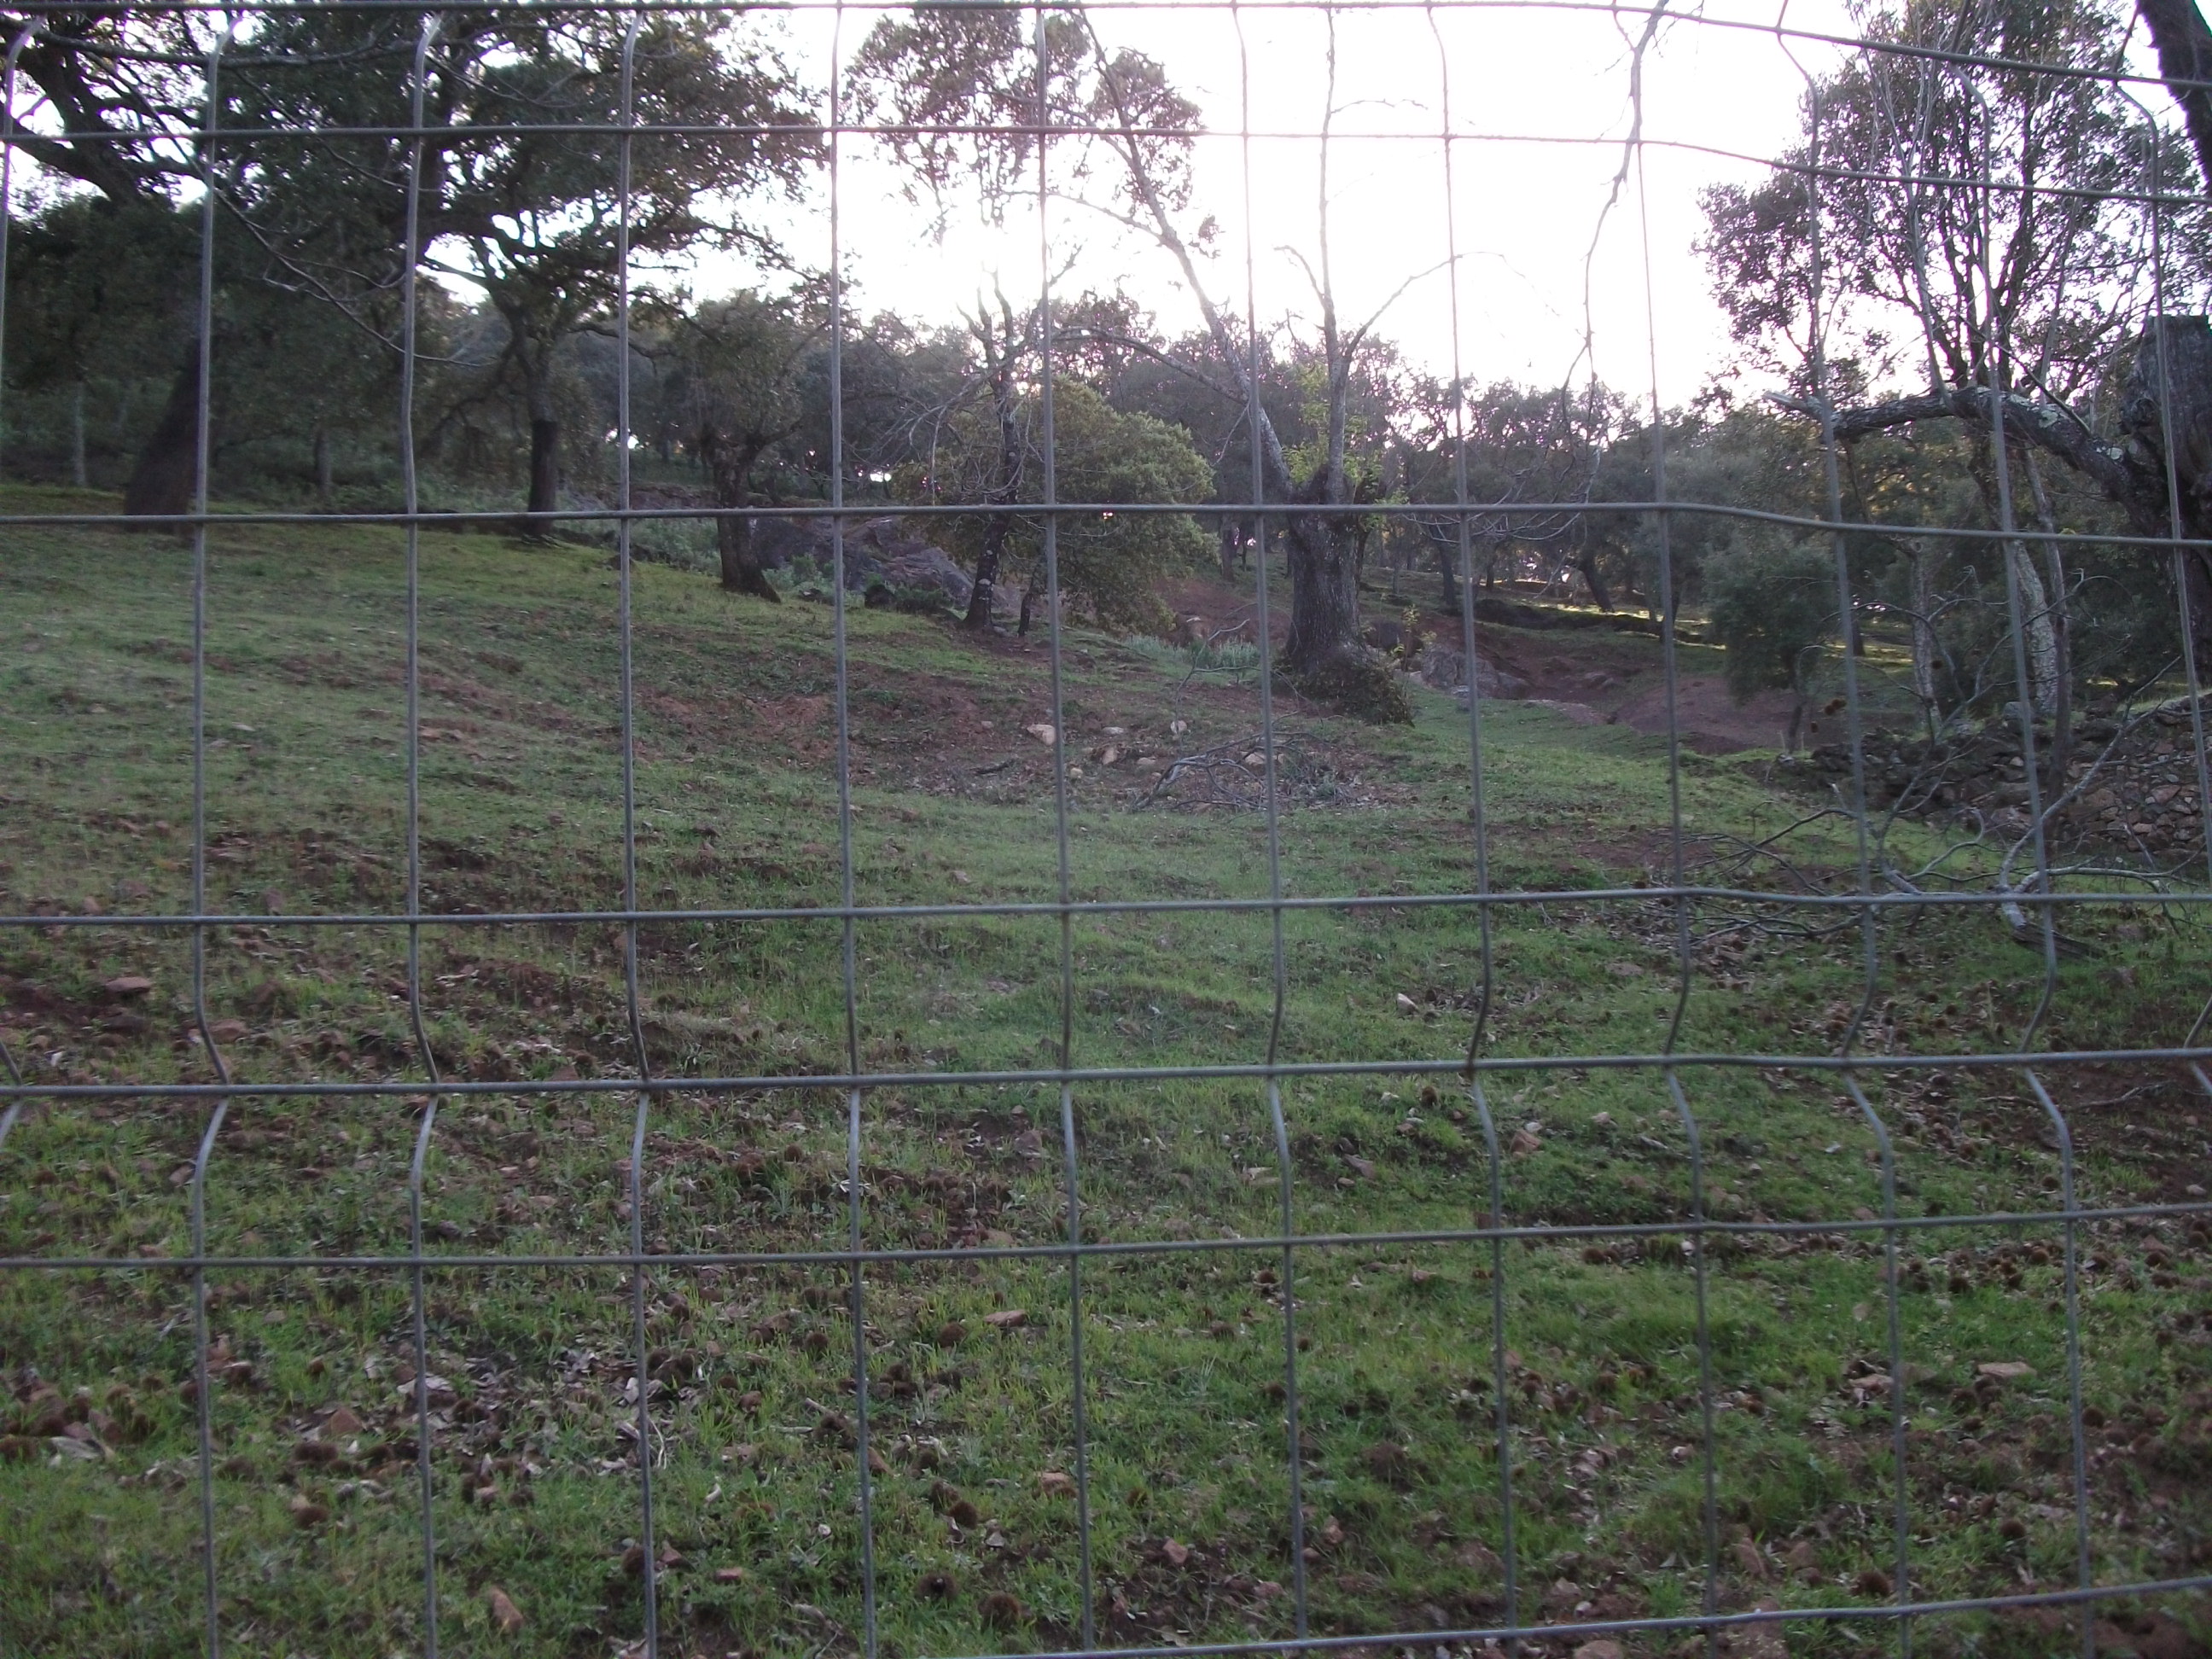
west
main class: Woodland
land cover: Broadleaved woodland
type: broadleaved evergreen forest
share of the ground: 50 - 75 %
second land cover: Grassland without tree/shrub cover
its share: > 75 %
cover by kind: broadleaved forest trees 70 %, herbaceous plants 30 %
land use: Forestry
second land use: Agriculture (excluding fallow land and kitchen gardens)
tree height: > 5 m
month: April
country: ES
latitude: 37.8619
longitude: -6.7207
